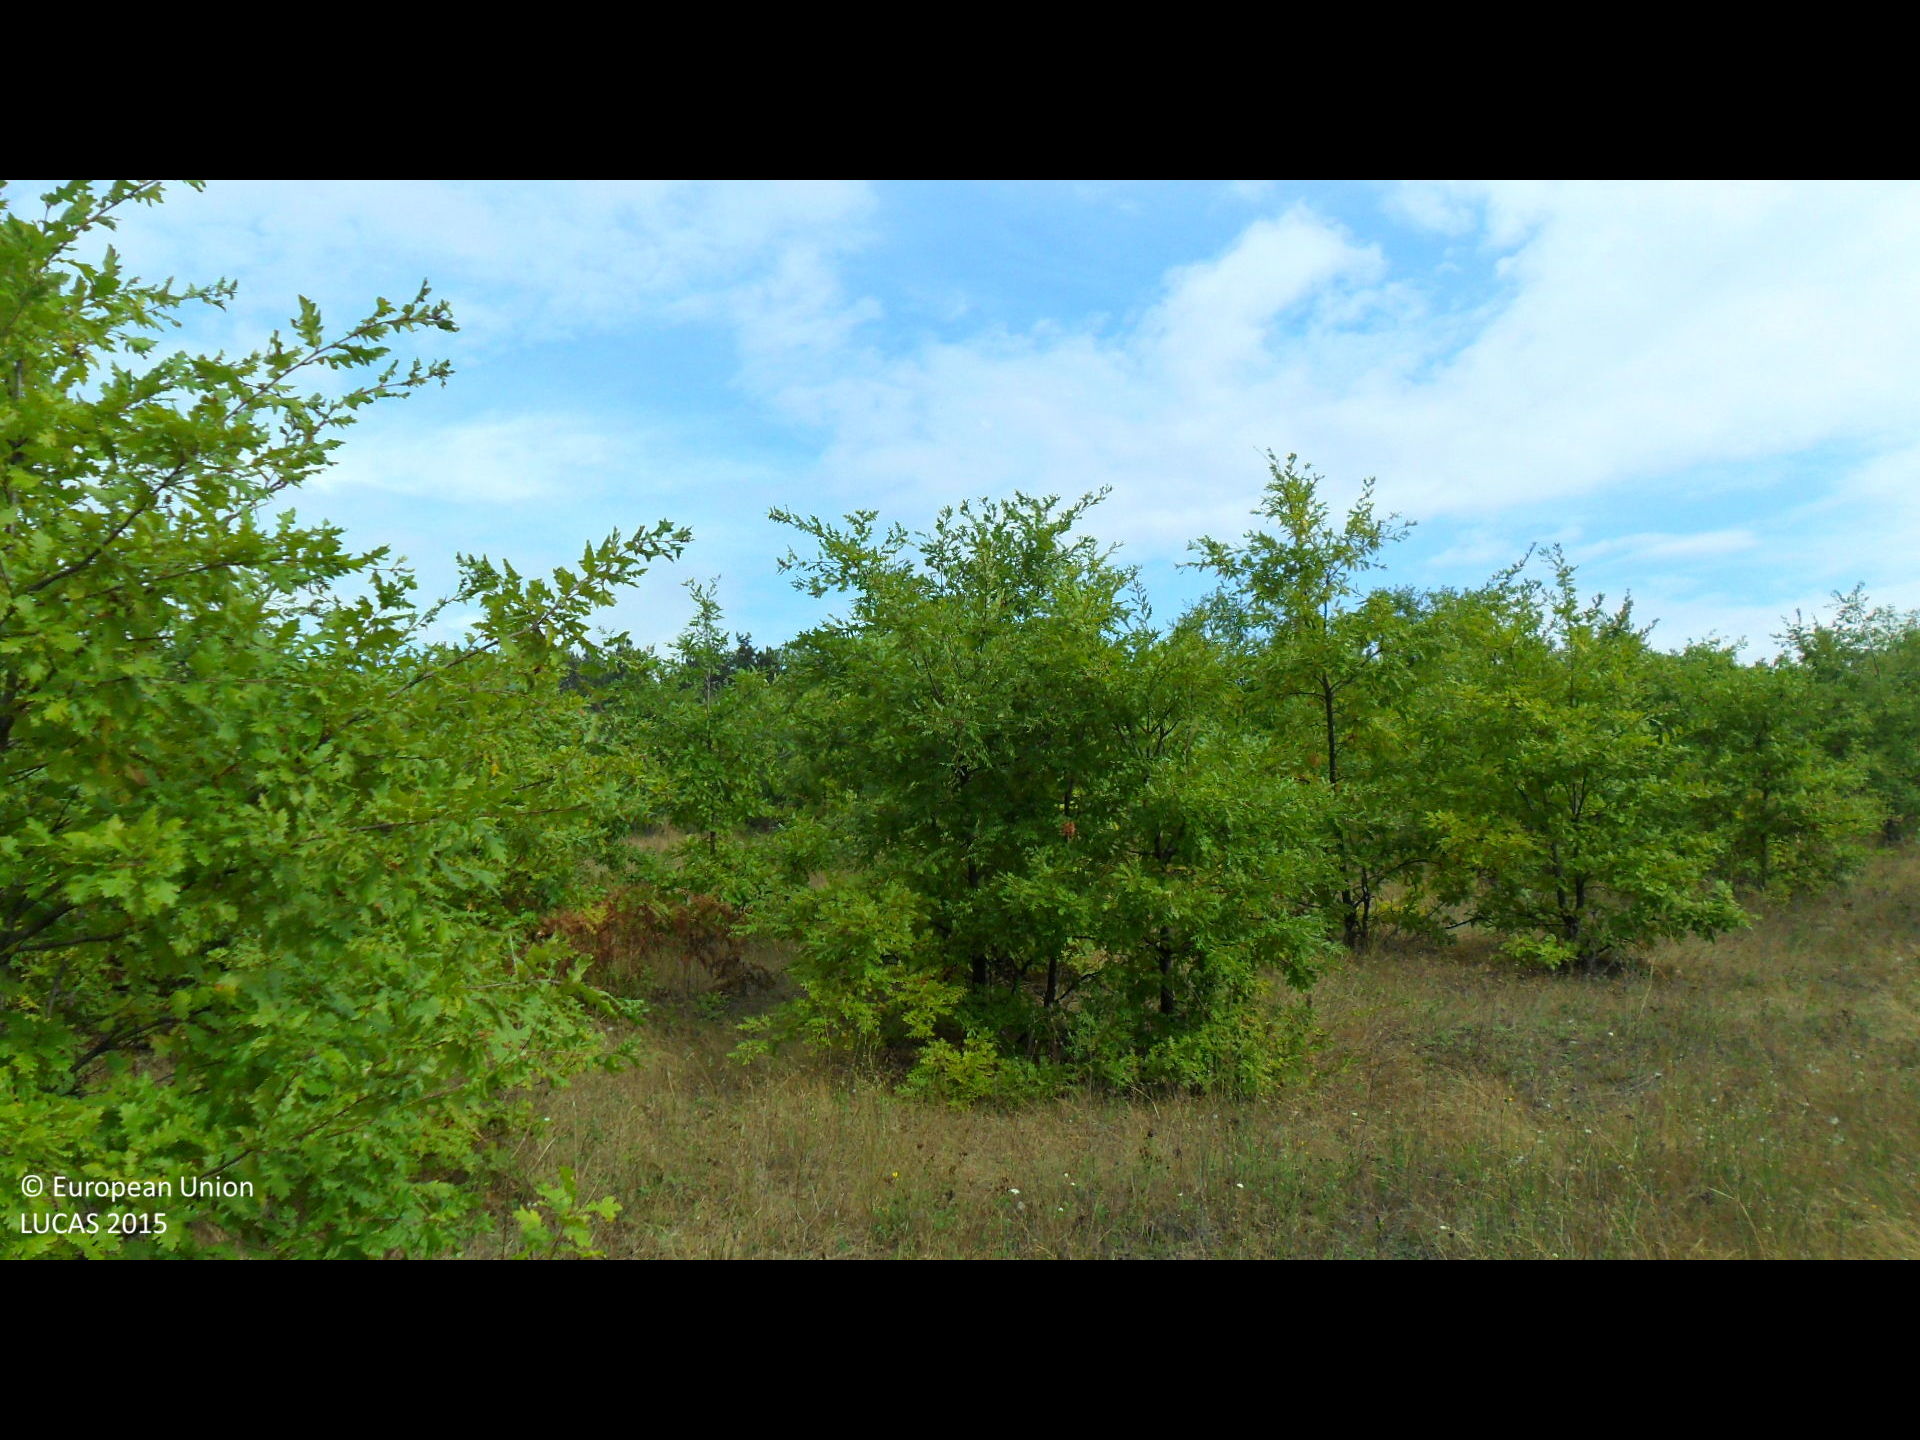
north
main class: Grassland
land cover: Grassland with sparse tree/shrub cover
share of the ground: > 75 %
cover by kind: herbaceous plants 90 %, broadleaved forest trees 5 %, shrubs 5 %
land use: Agriculture (excluding fallow land and kitchen gardens)
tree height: < 5 m
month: September
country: BG
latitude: 43.0863
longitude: 26.4232
